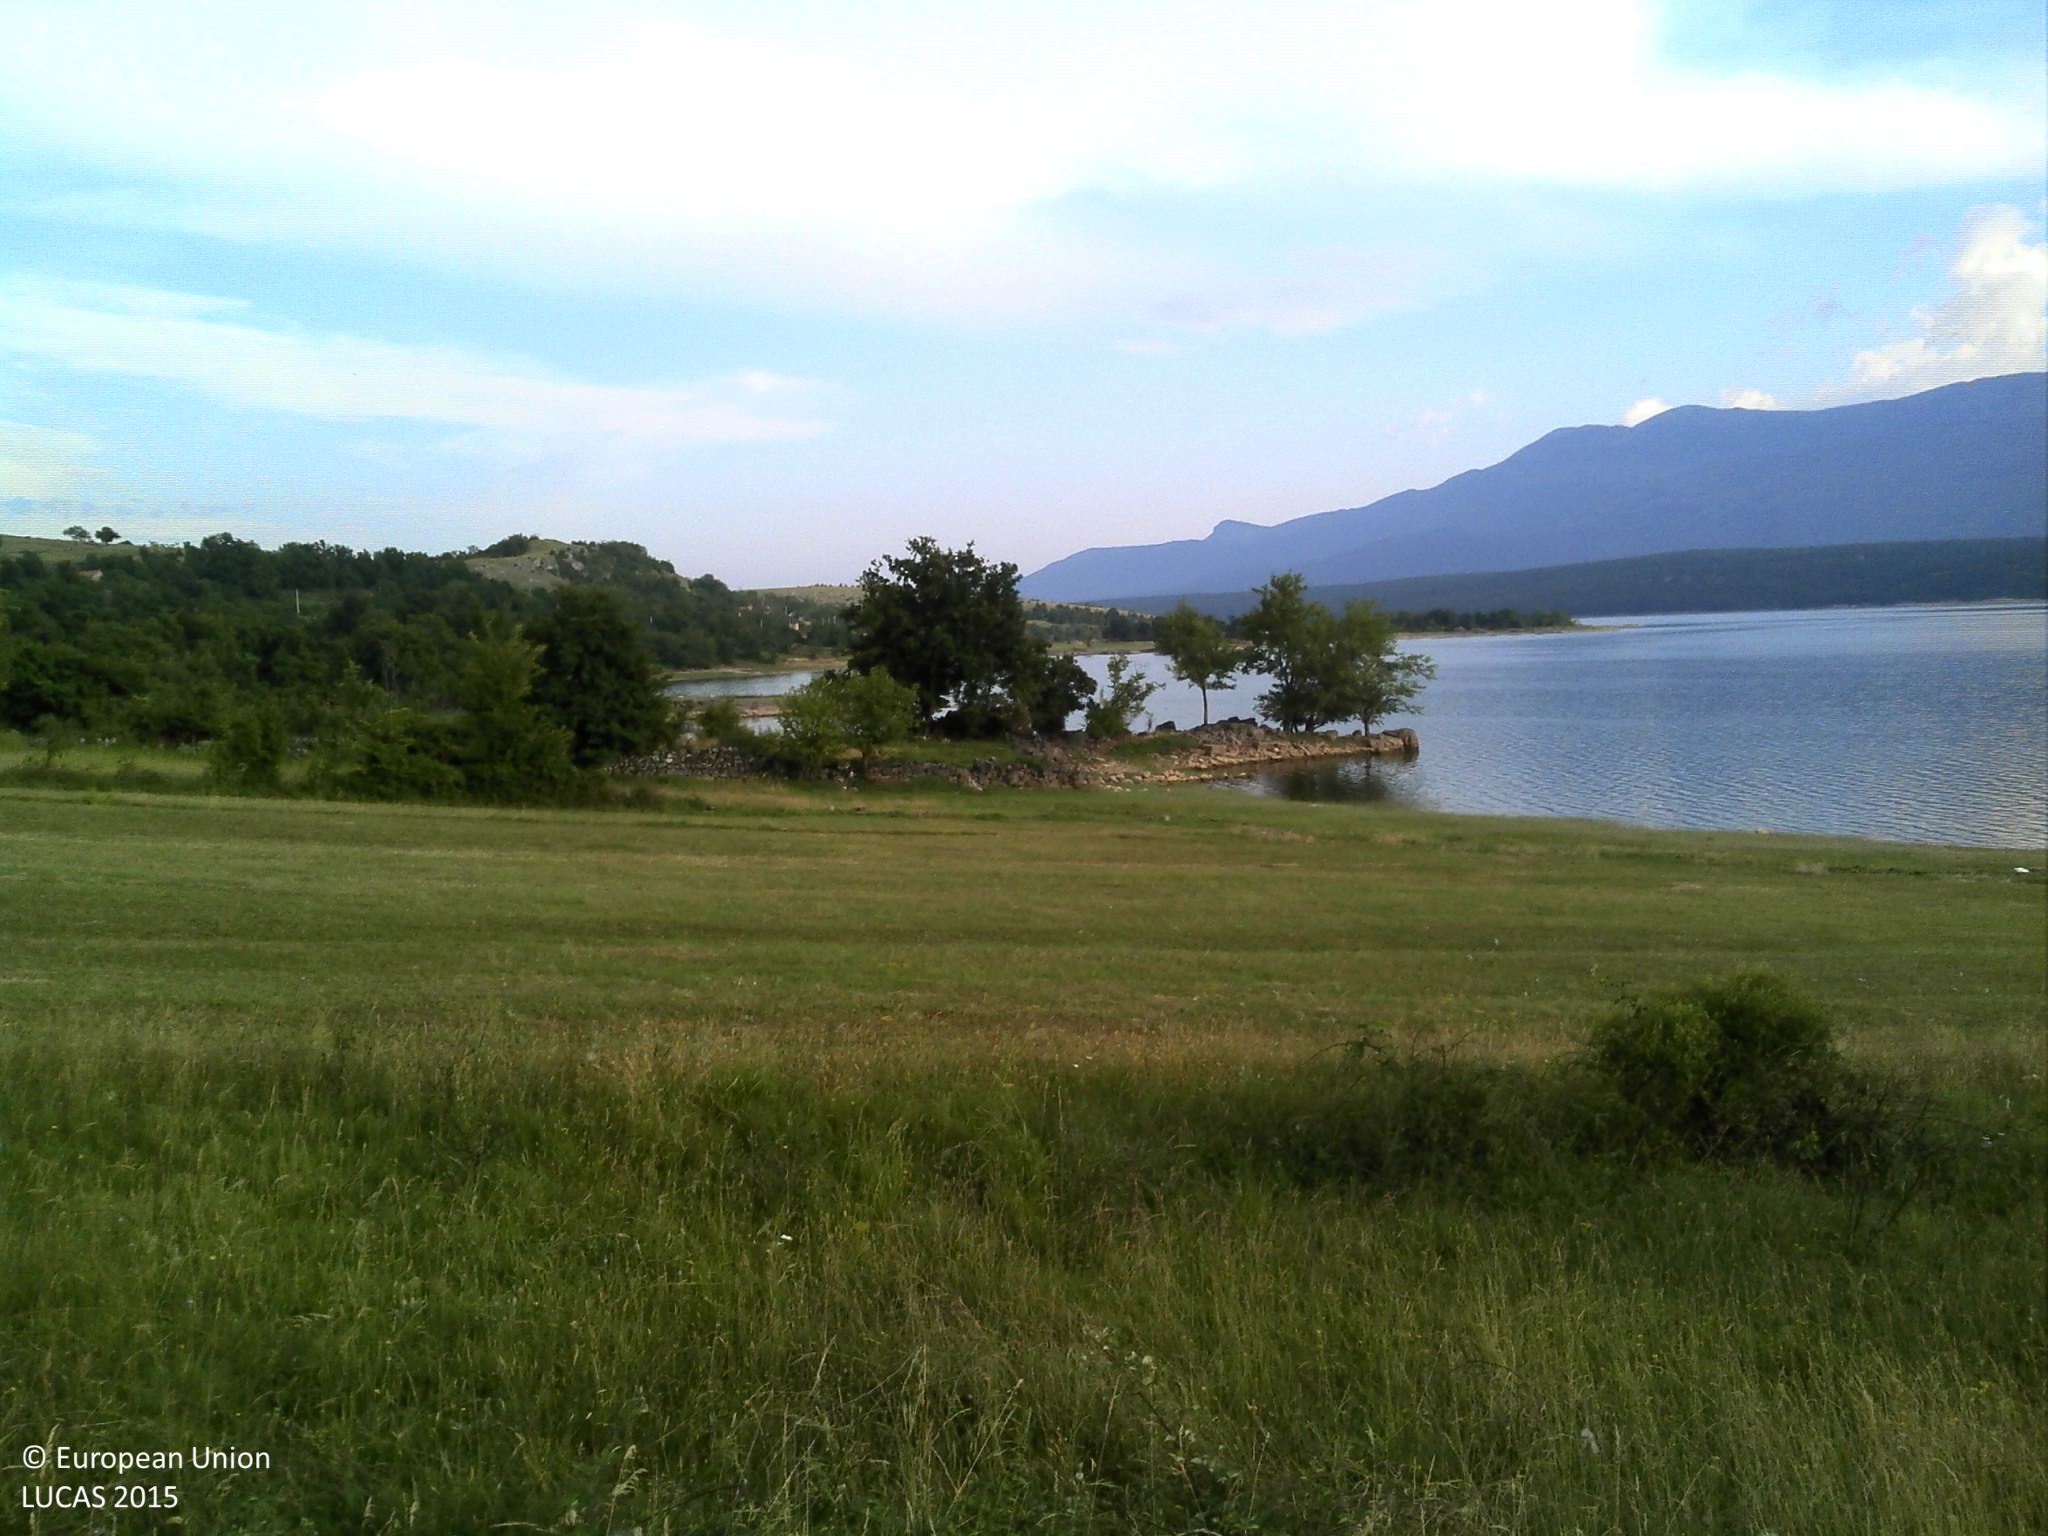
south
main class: Grassland
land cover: Grassland with sparse tree/shrub cover
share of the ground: > 75 %
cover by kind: herbaceous plants 90 %, broadleaved forest trees 5 %, shrubs 5 %
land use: Agriculture (excluding fallow land and kitchen gardens)
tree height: < 5 m
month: June
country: HR
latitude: 43.8948
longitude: 16.4783
